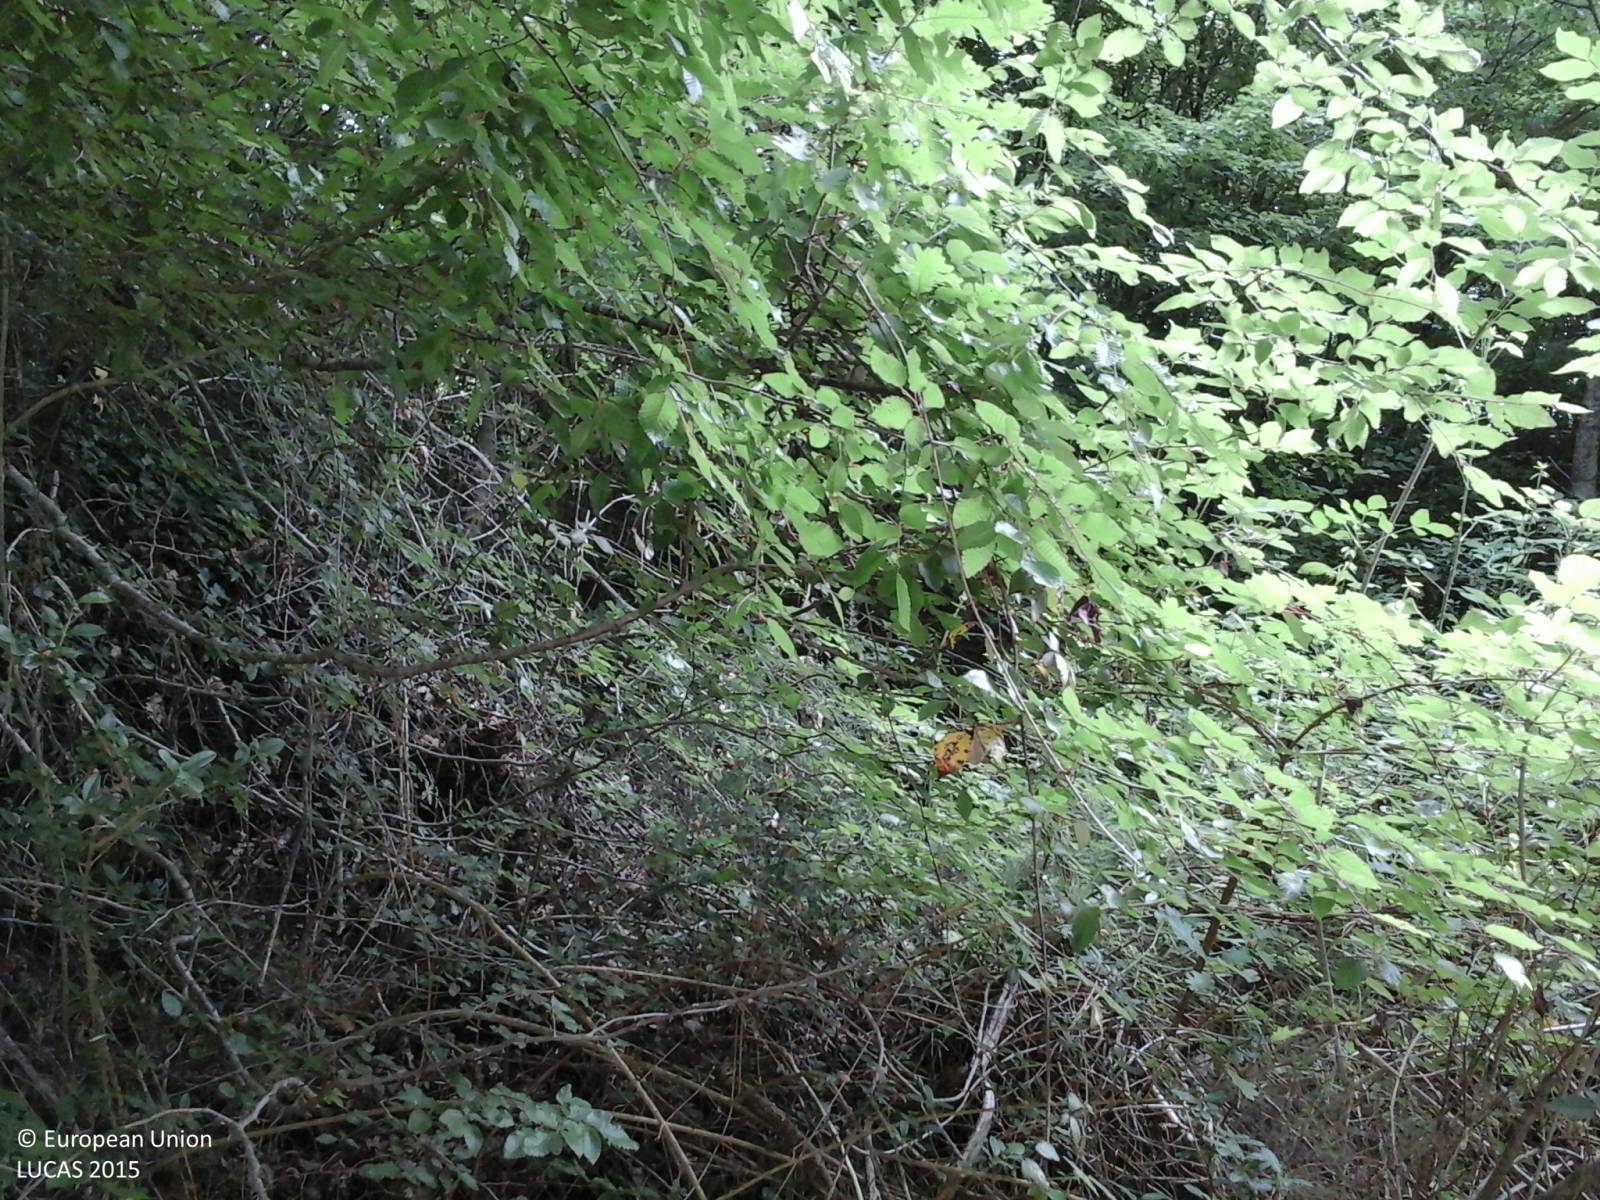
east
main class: Woodland
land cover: Broadleaved woodland
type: thermophilous deciduous forest
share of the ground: > 75 %
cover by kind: broadleaved forest trees 100 %
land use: Forestry
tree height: < 5 m
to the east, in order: Broadleaved woodland; Paved roads, cycling and walking lanes; Broadleaved woodland; Tracks; Broadleaved woodland
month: May
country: IT
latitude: 41.2432
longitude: 14.2673
